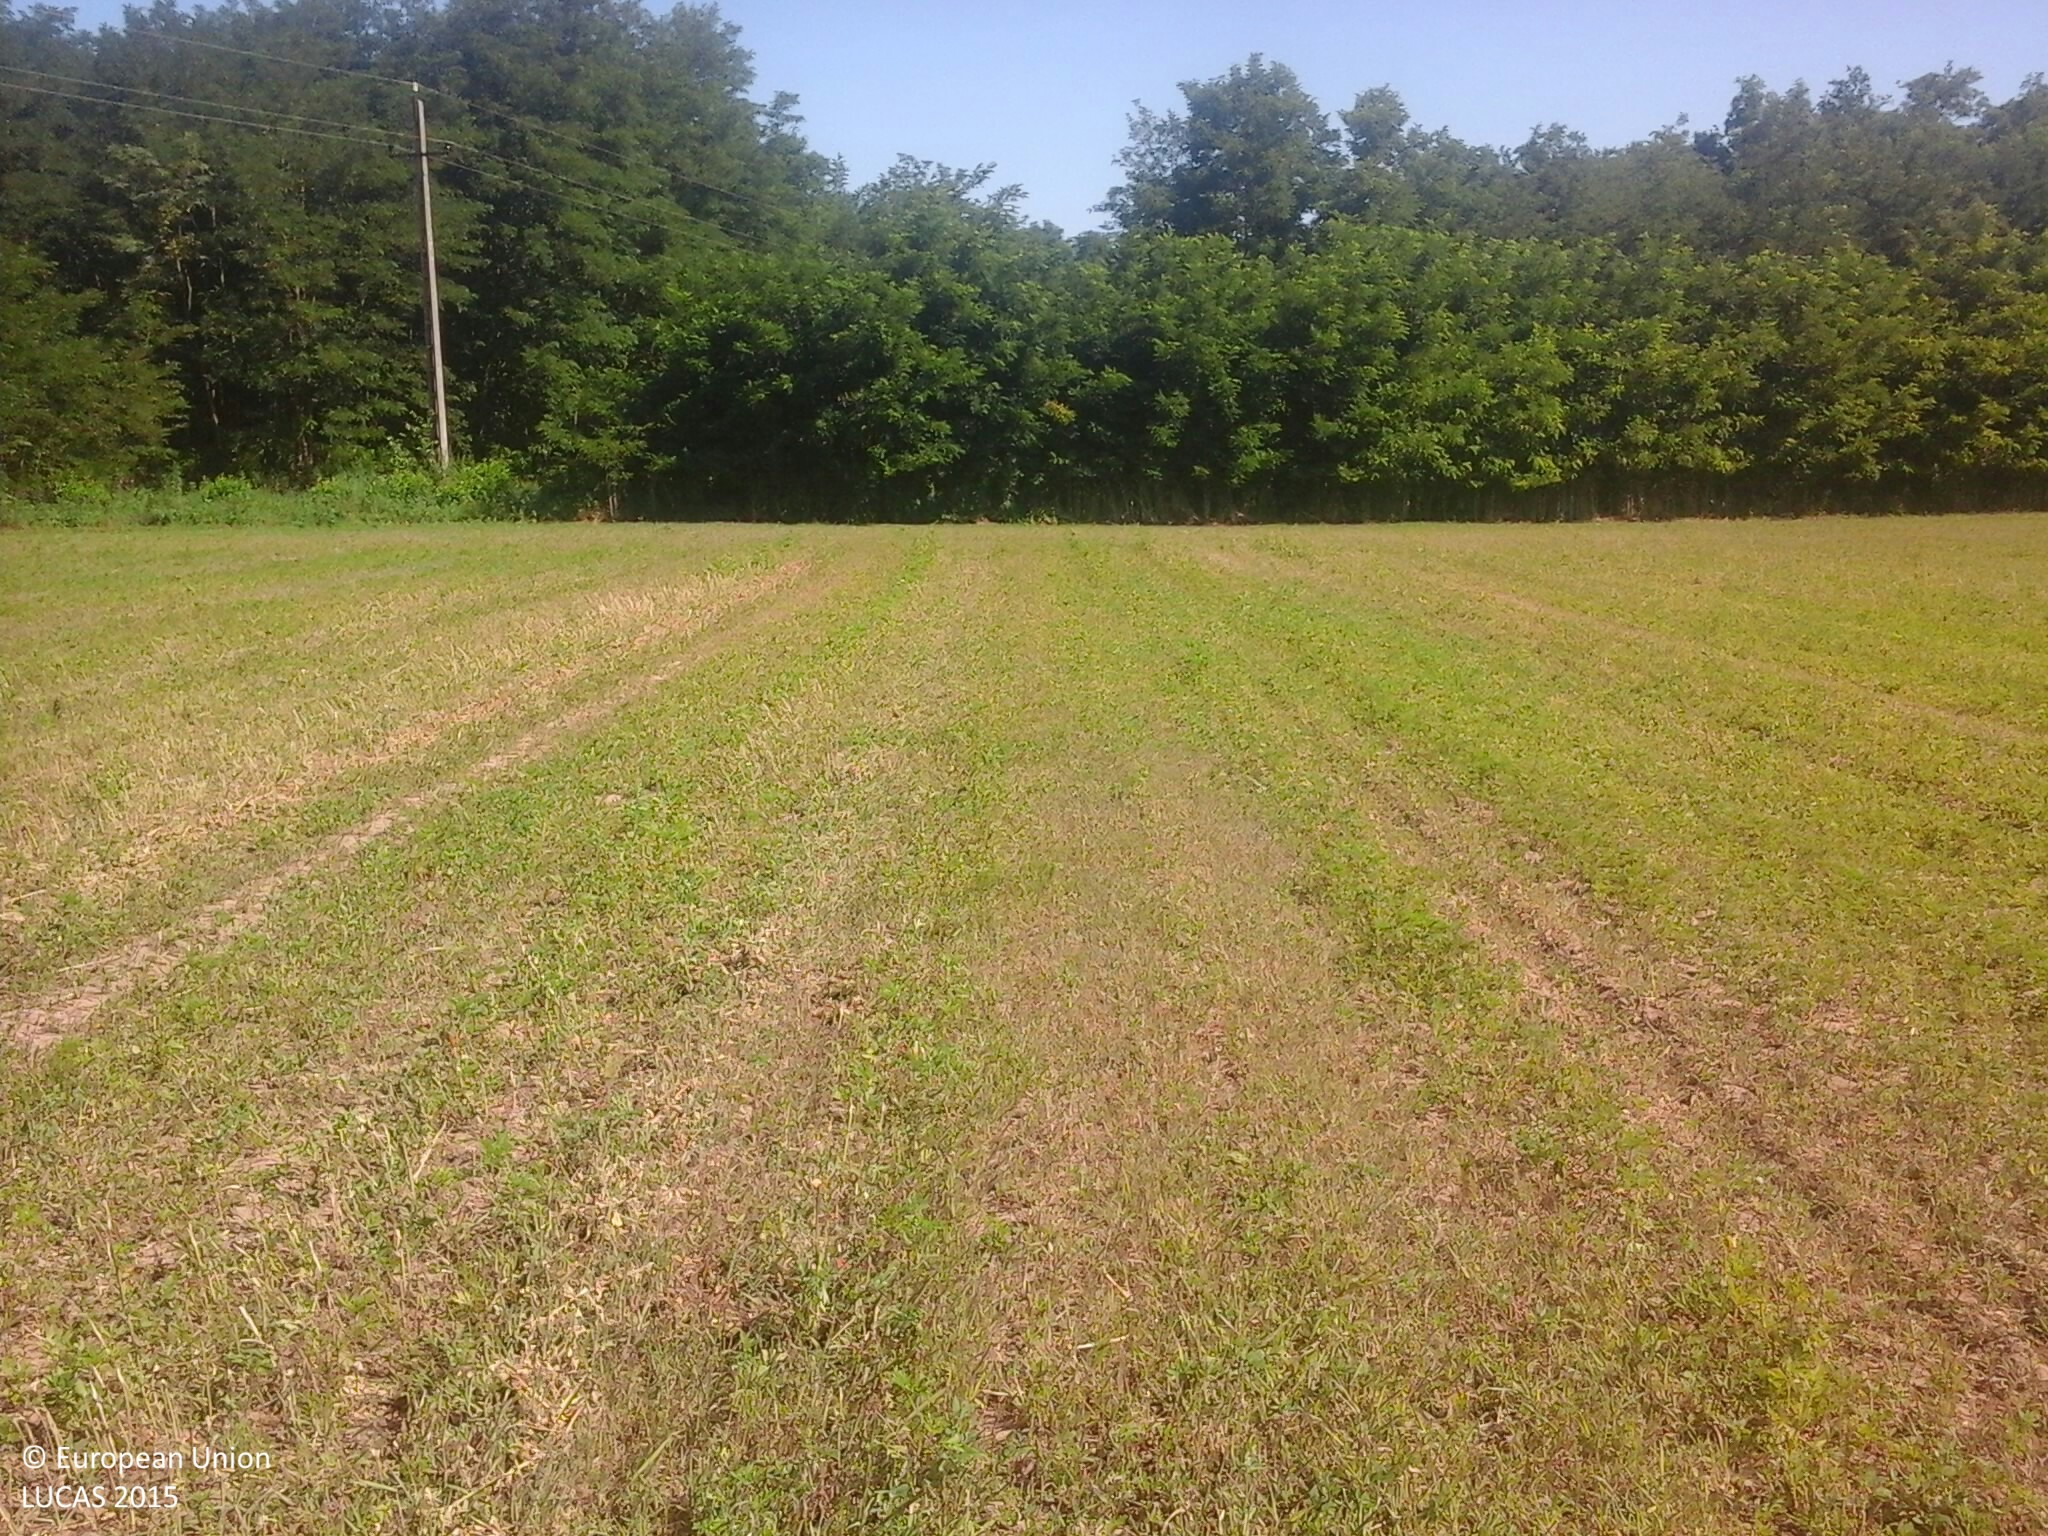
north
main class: Cropland
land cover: Lucerne
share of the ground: > 75 %
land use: Agriculture (excluding fallow land and kitchen gardens)
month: July
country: HU
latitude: 47.8842
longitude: 21.9119
